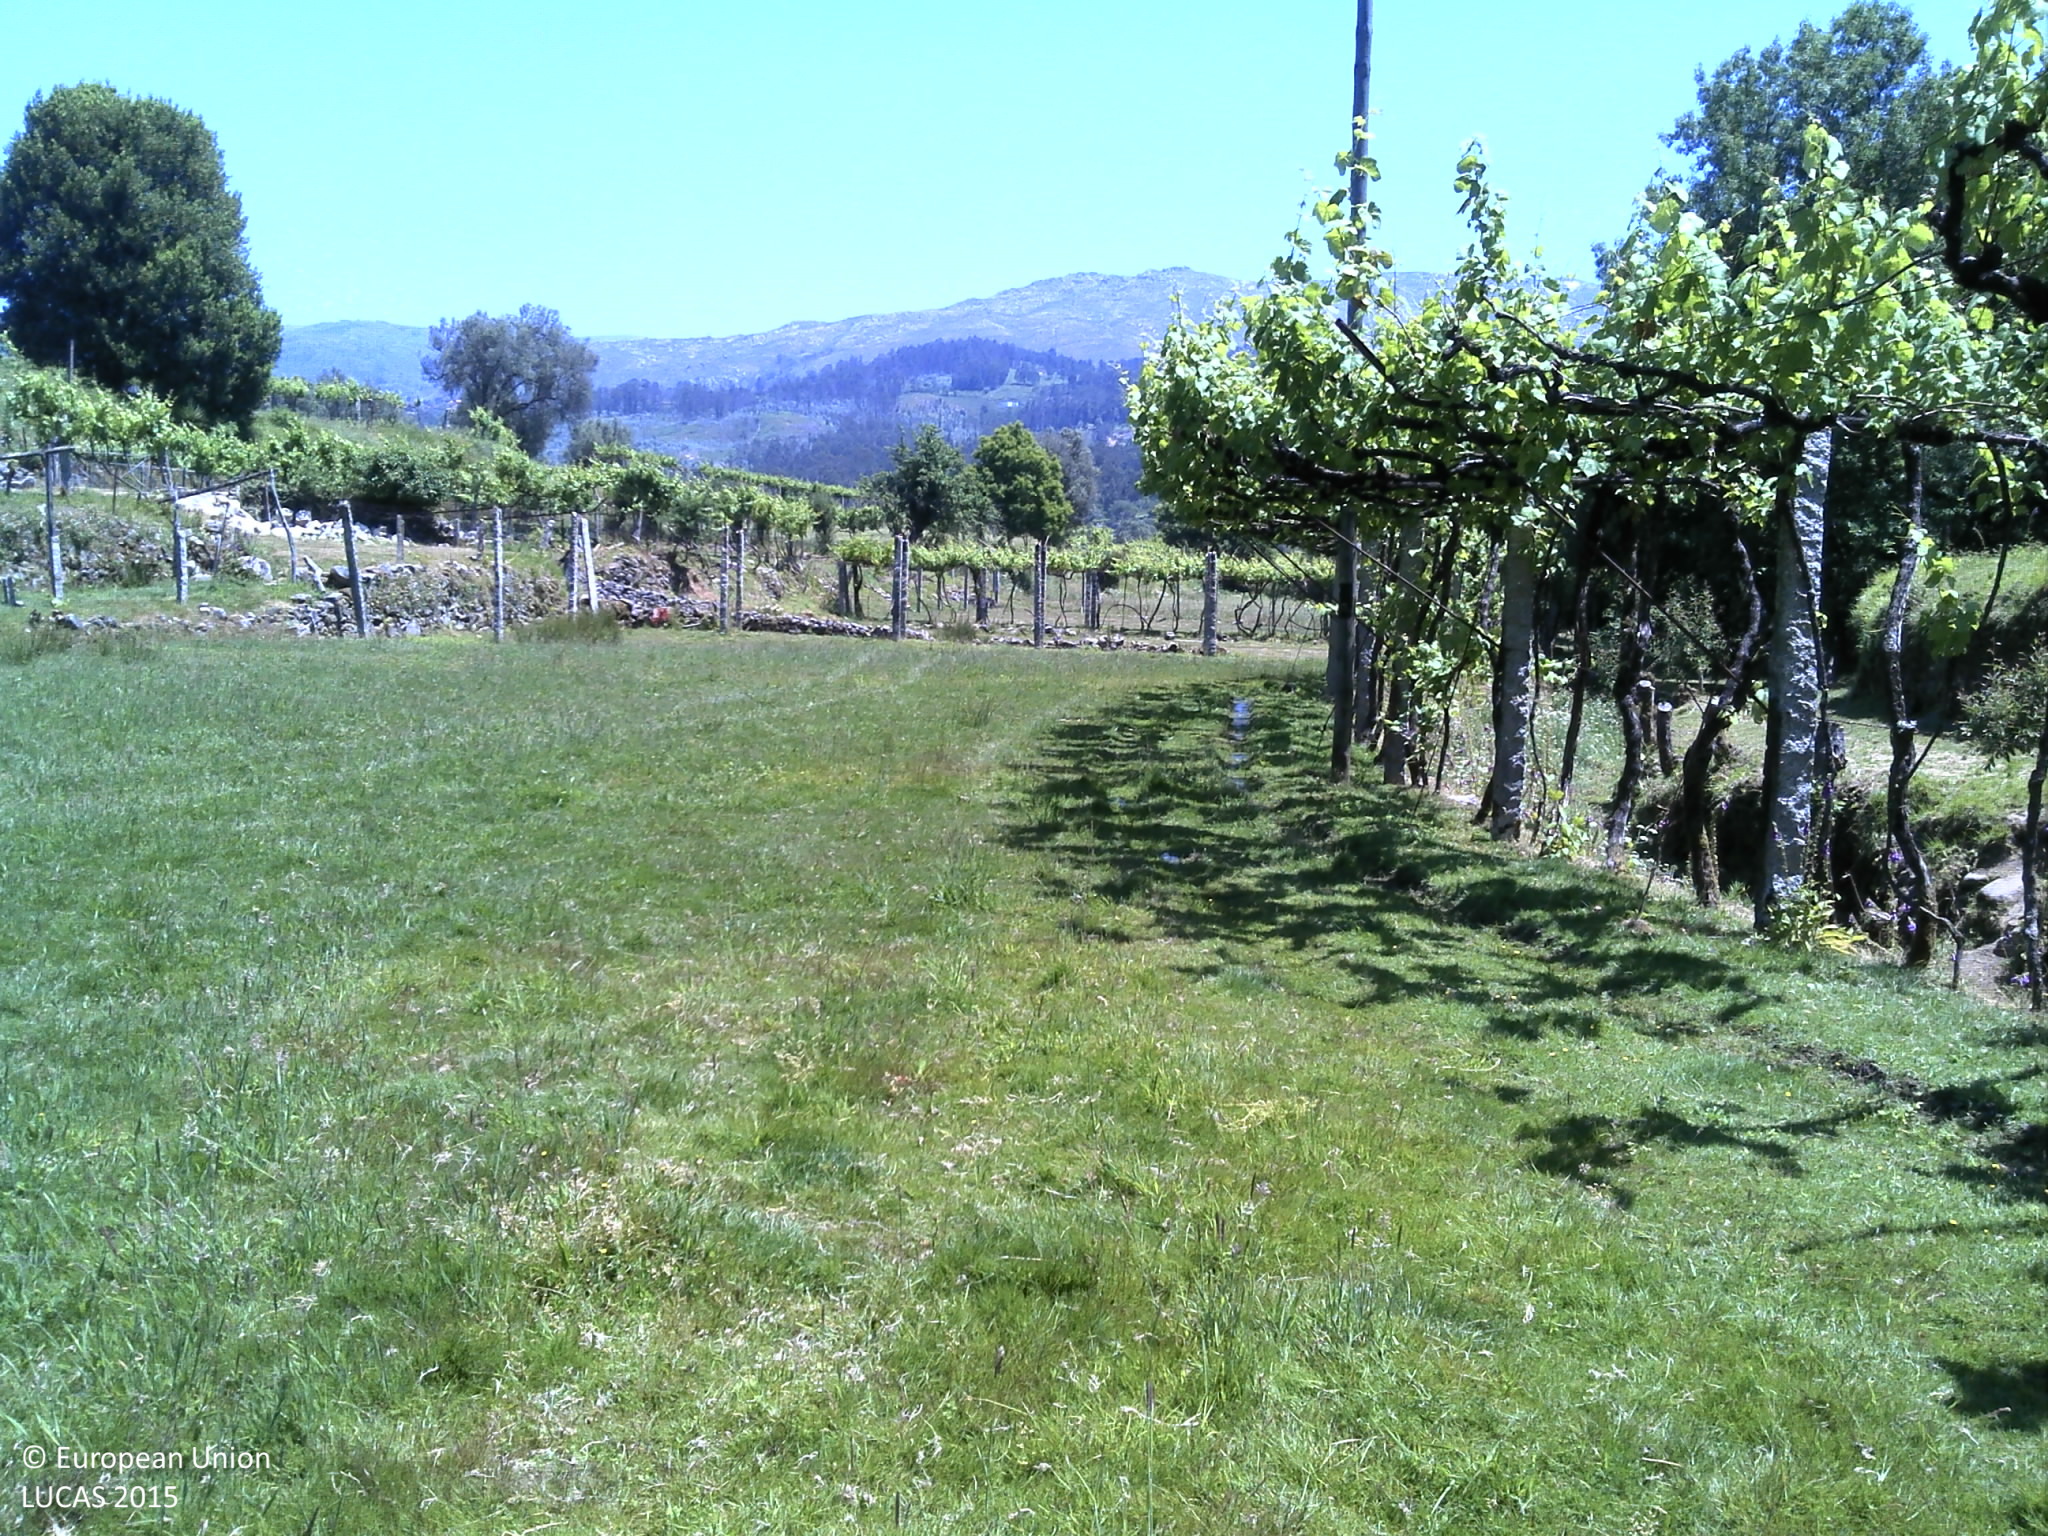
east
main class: Cropland
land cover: Temporary grasslands
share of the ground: > 75 %
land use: Agriculture (excluding fallow land and kitchen gardens)
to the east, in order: Temporary grasslands; Electric lines; Temporary grasslands; Fences; Grassland without tree/shrub cover; Vineyards; Fences; Grassland without tree/shrub cover; Vineyards; Fences; Grassland without tree/shrub cover; Fences; Grassland without tree/shrub cover; Spontaneously vegetated surfaces; Vineyards; Grassland without tree/shrub cover
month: June
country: PT
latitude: 41.9205
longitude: -8.4523
